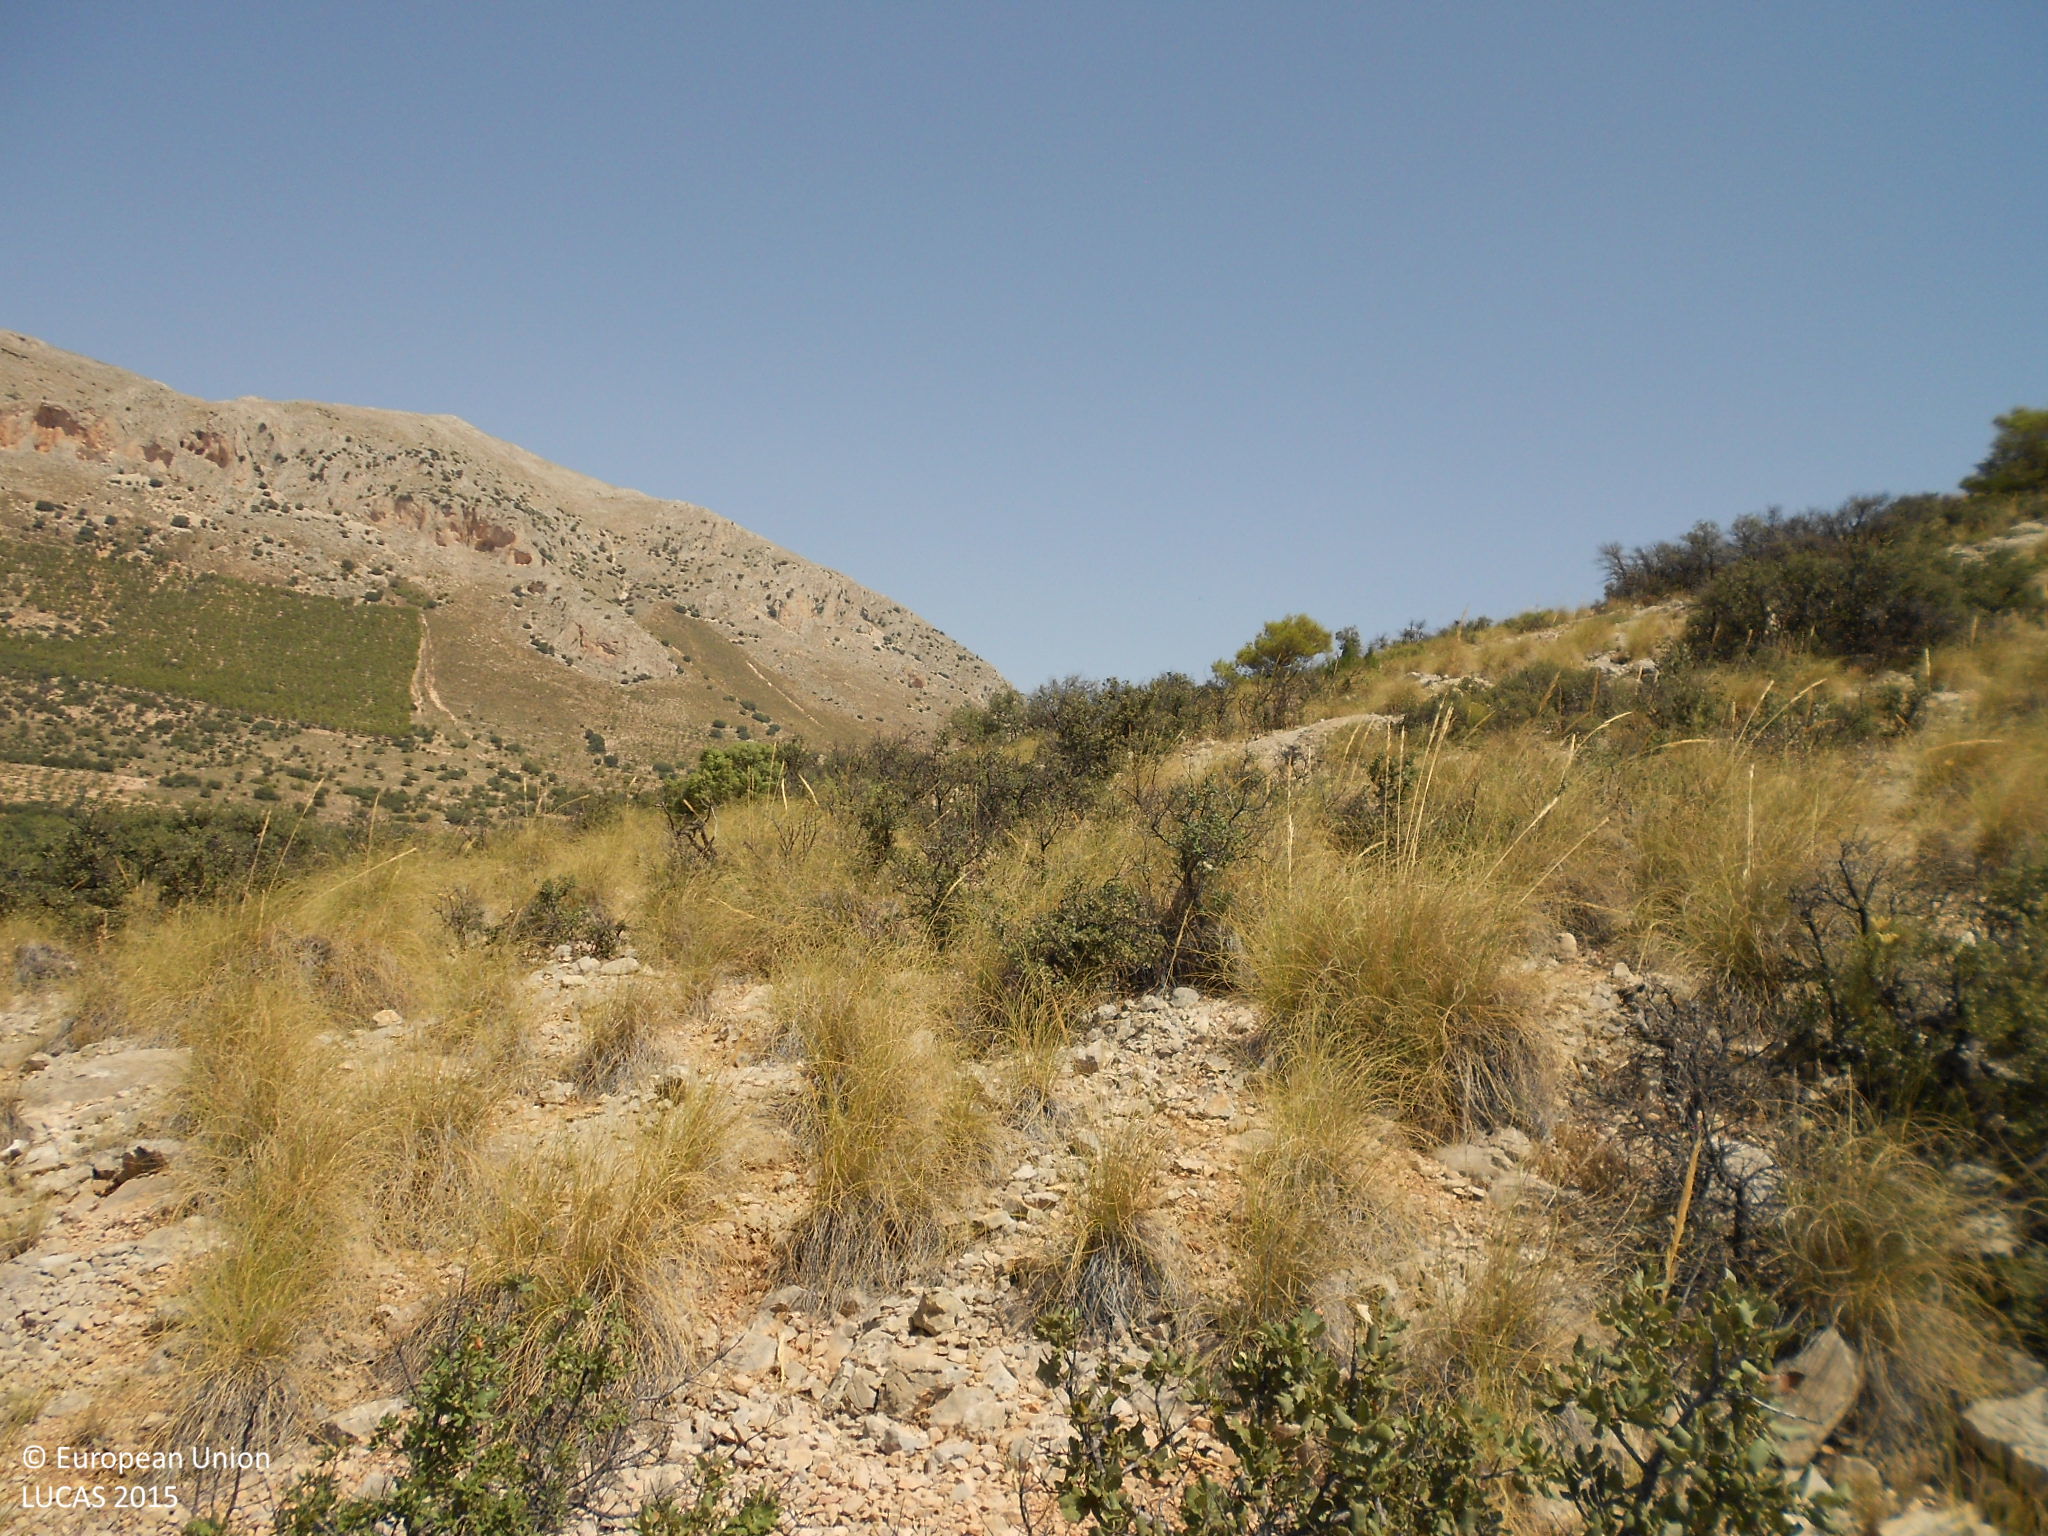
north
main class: Shrubland
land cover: Shrubland without tree cover
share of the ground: 50 - 75 %
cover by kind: shrubs 60 %, herbaceous plants 20 %, consolidated bare surface 20 %
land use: Semi-natural and natural areas not in use
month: July
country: ES
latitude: 37.6322
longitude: -2.2347
